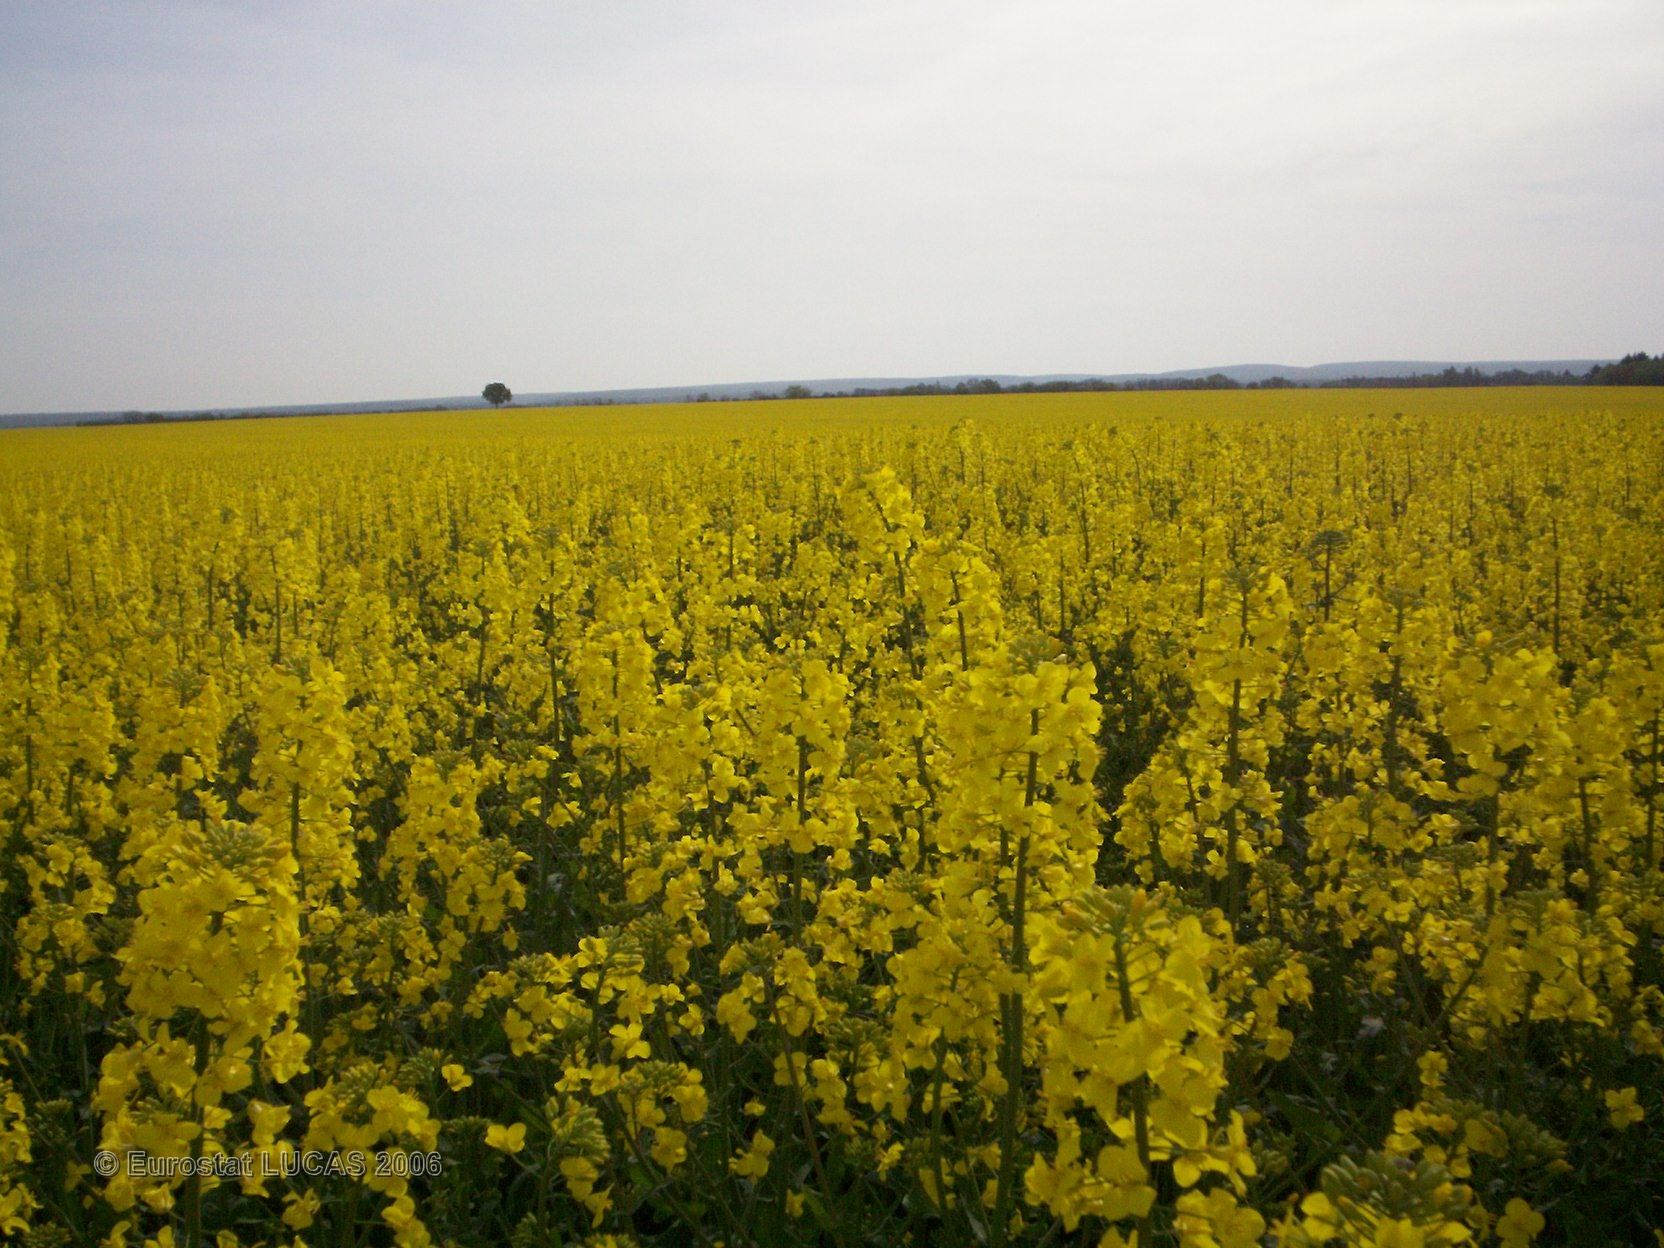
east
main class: Cropland
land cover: Rape and turnip rape
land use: Agriculture (excluding fallow land and kitchen gardens)
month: May
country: FR
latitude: 47.2998
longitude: 3.0518
